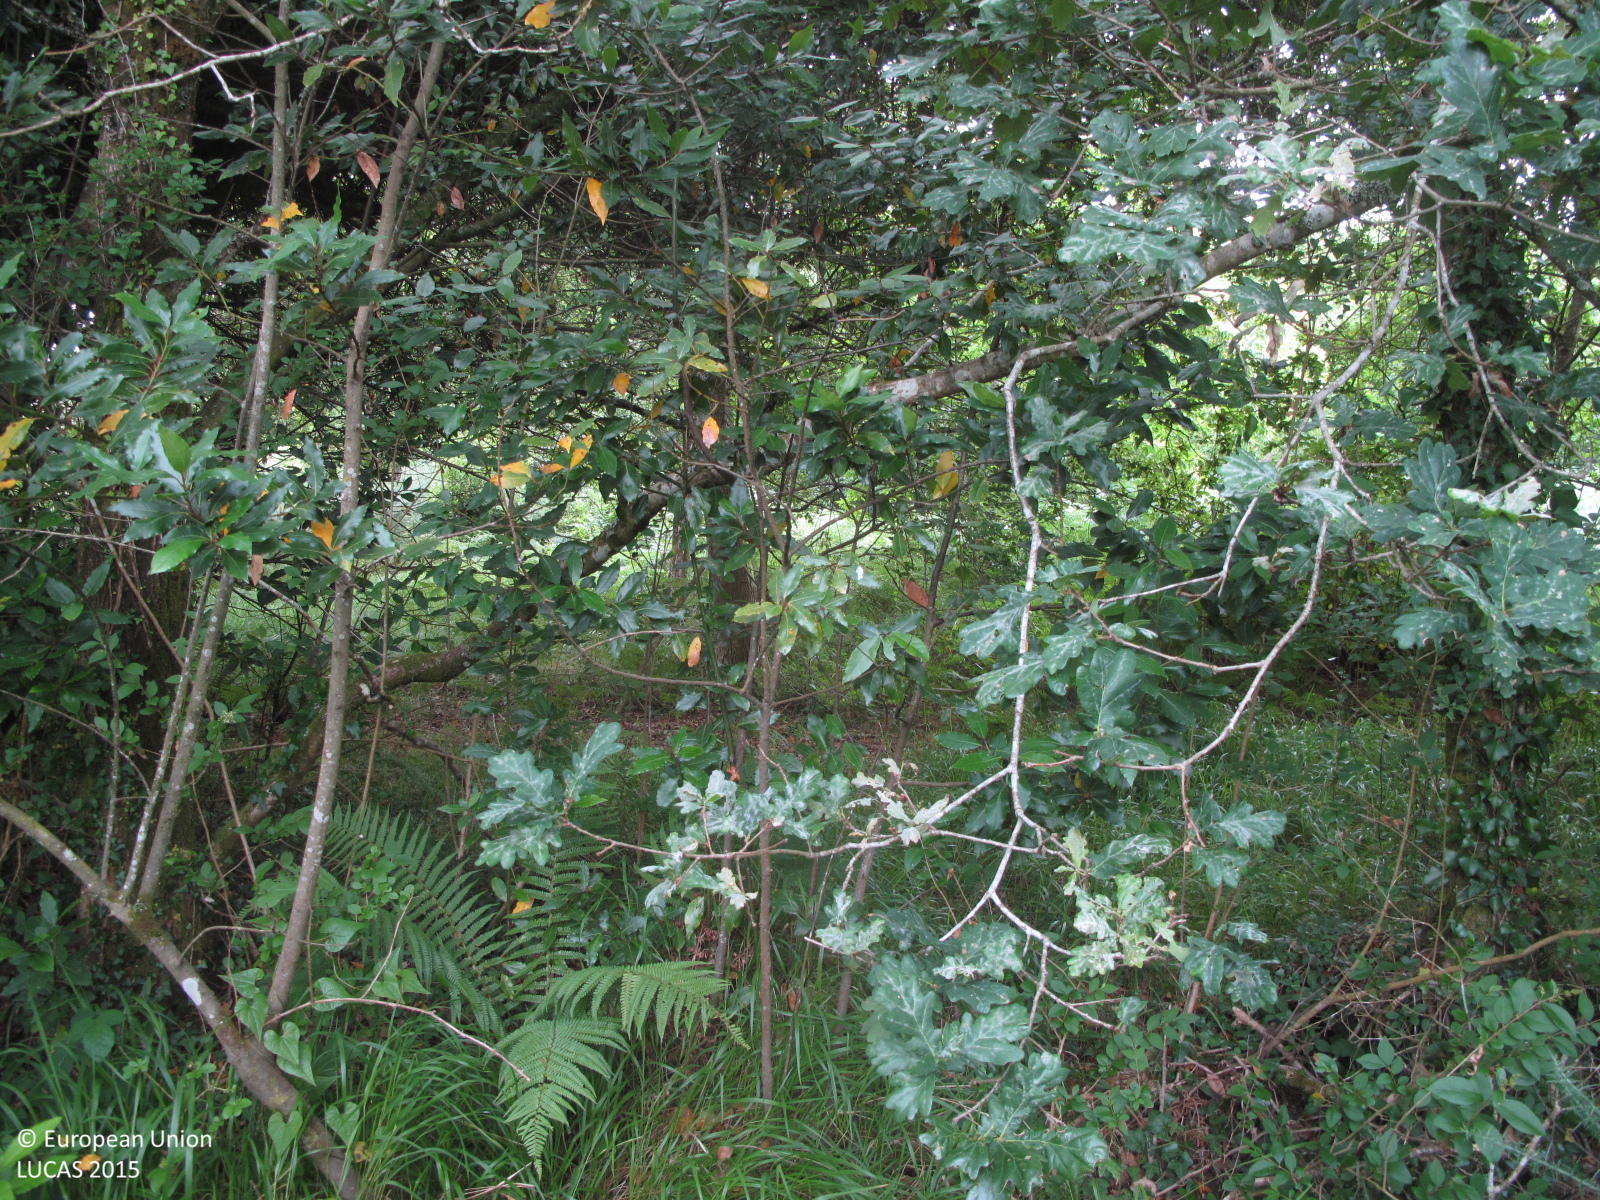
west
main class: Woodland
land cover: Broadleaved woodland
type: exotic forest
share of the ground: 25 - 50 %
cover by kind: shrubs 60 %, broadleaved forest trees 30 %, herbaceous plants 10 %
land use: Forestry
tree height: < 5 m
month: July
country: ES
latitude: 43.5173
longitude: -7.9971
